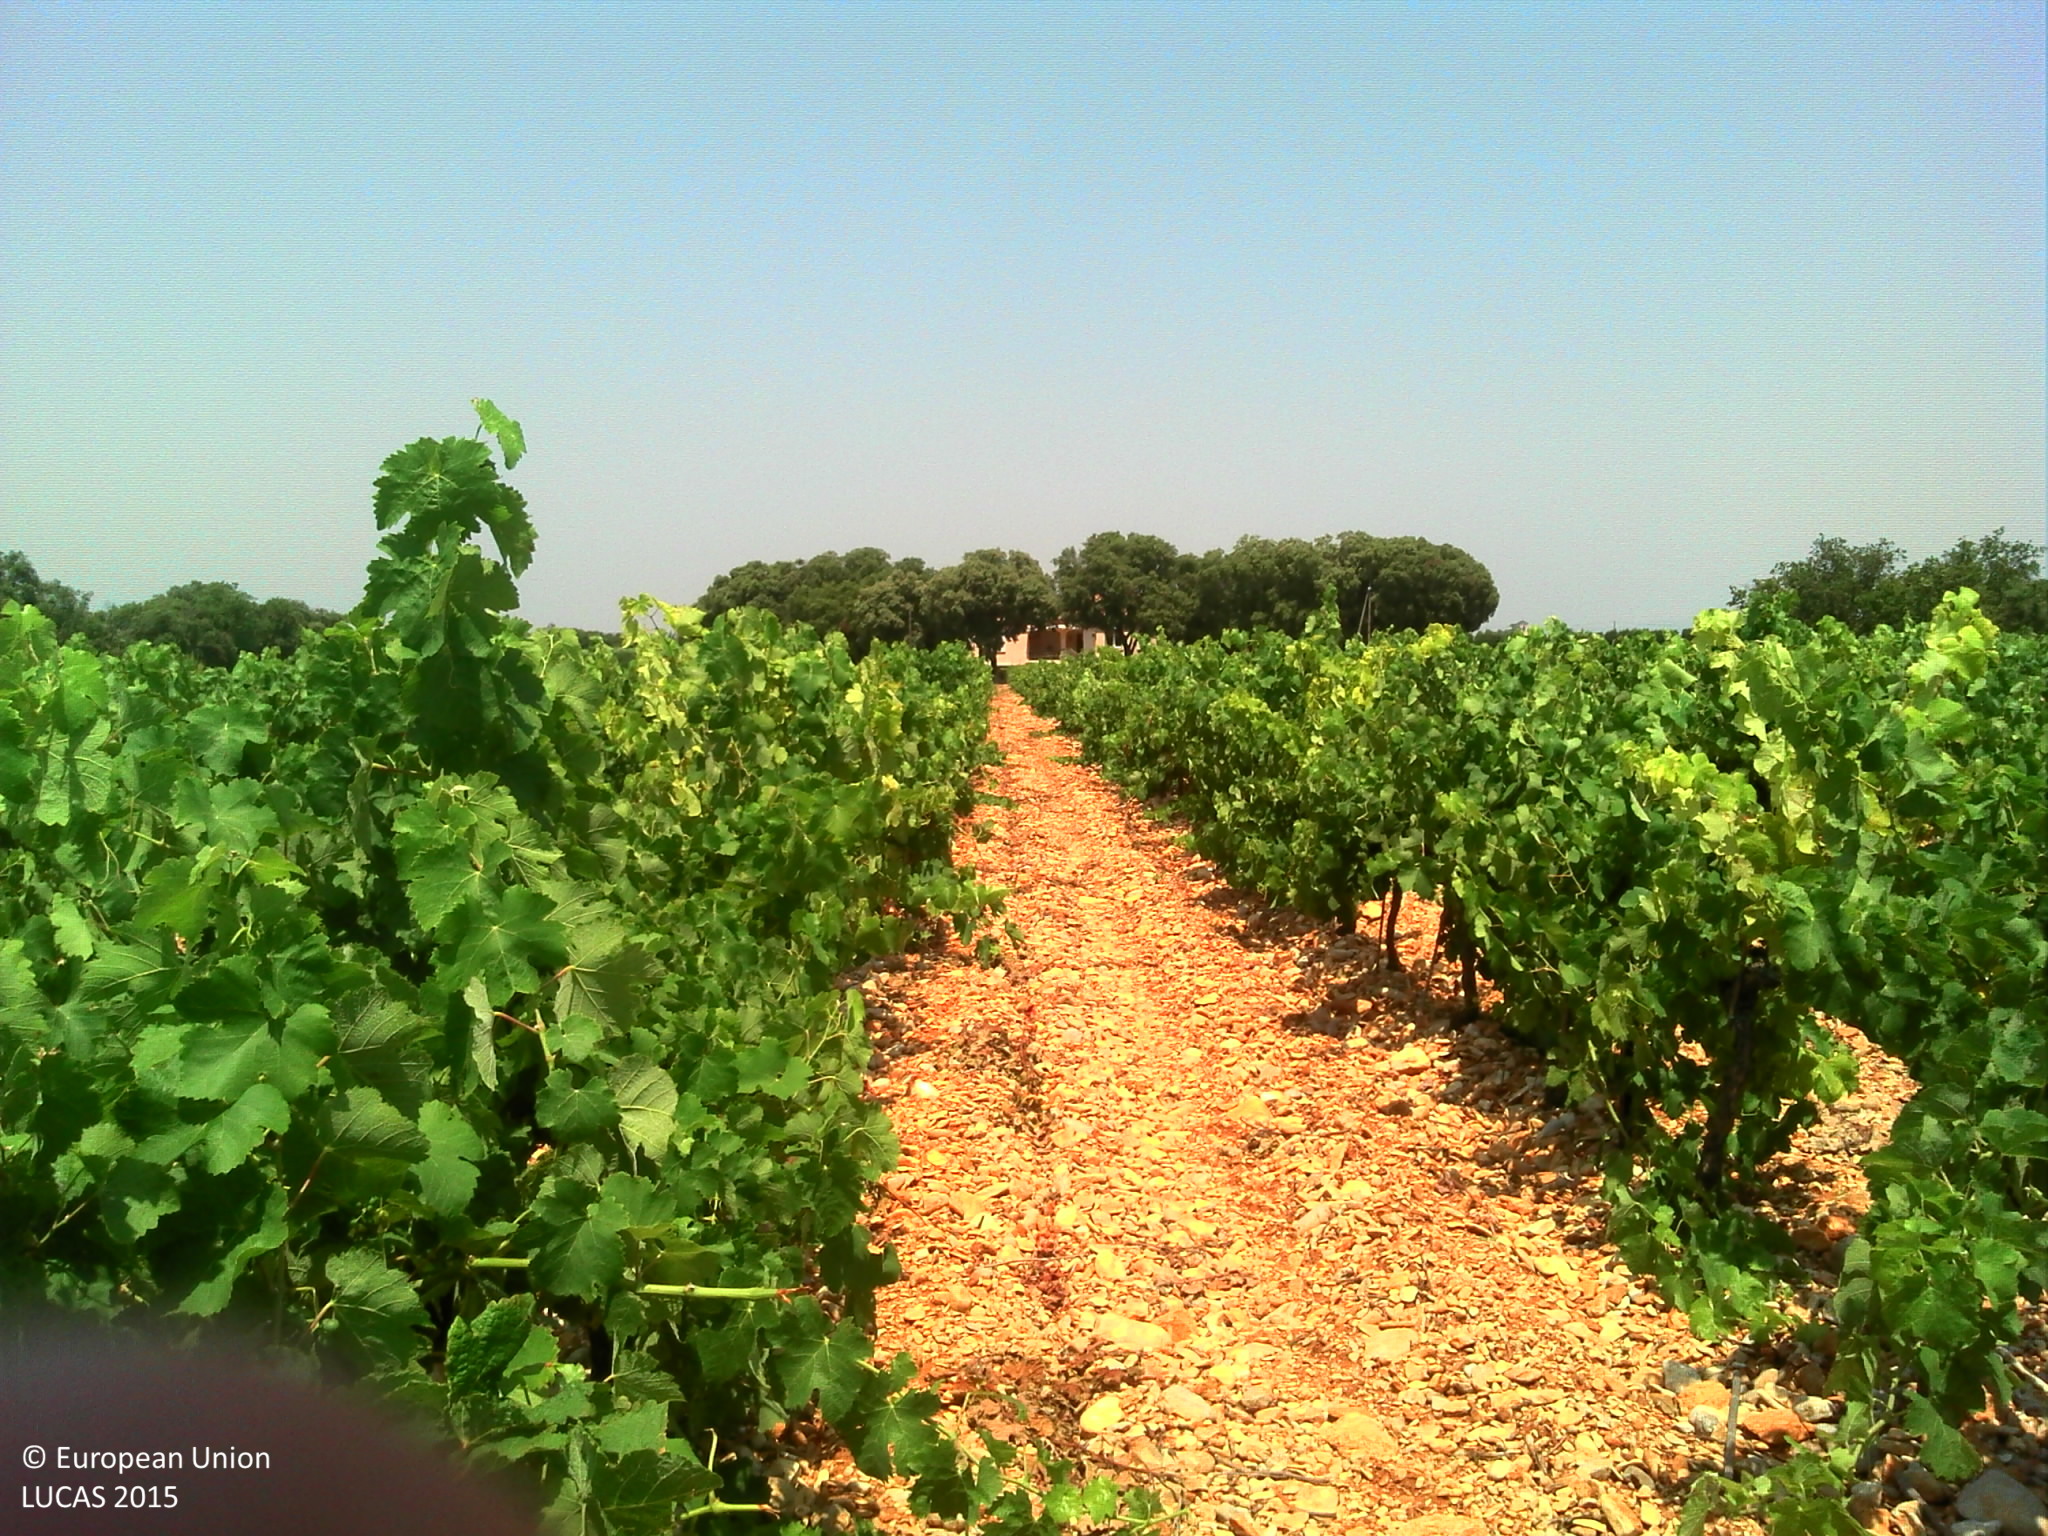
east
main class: Cropland
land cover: Vineyards
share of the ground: 25 - 50 %
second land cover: Other bare soil
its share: > 75 %
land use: Agriculture (excluding fallow land and kitchen gardens)
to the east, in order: Vineyards; Other bare soil; Grass margins; Paved roads, cycling and walking lanes; Grass margins; Fences; Other fruit trees and berries
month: July
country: FR
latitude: 44.2761
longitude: 4.8330
